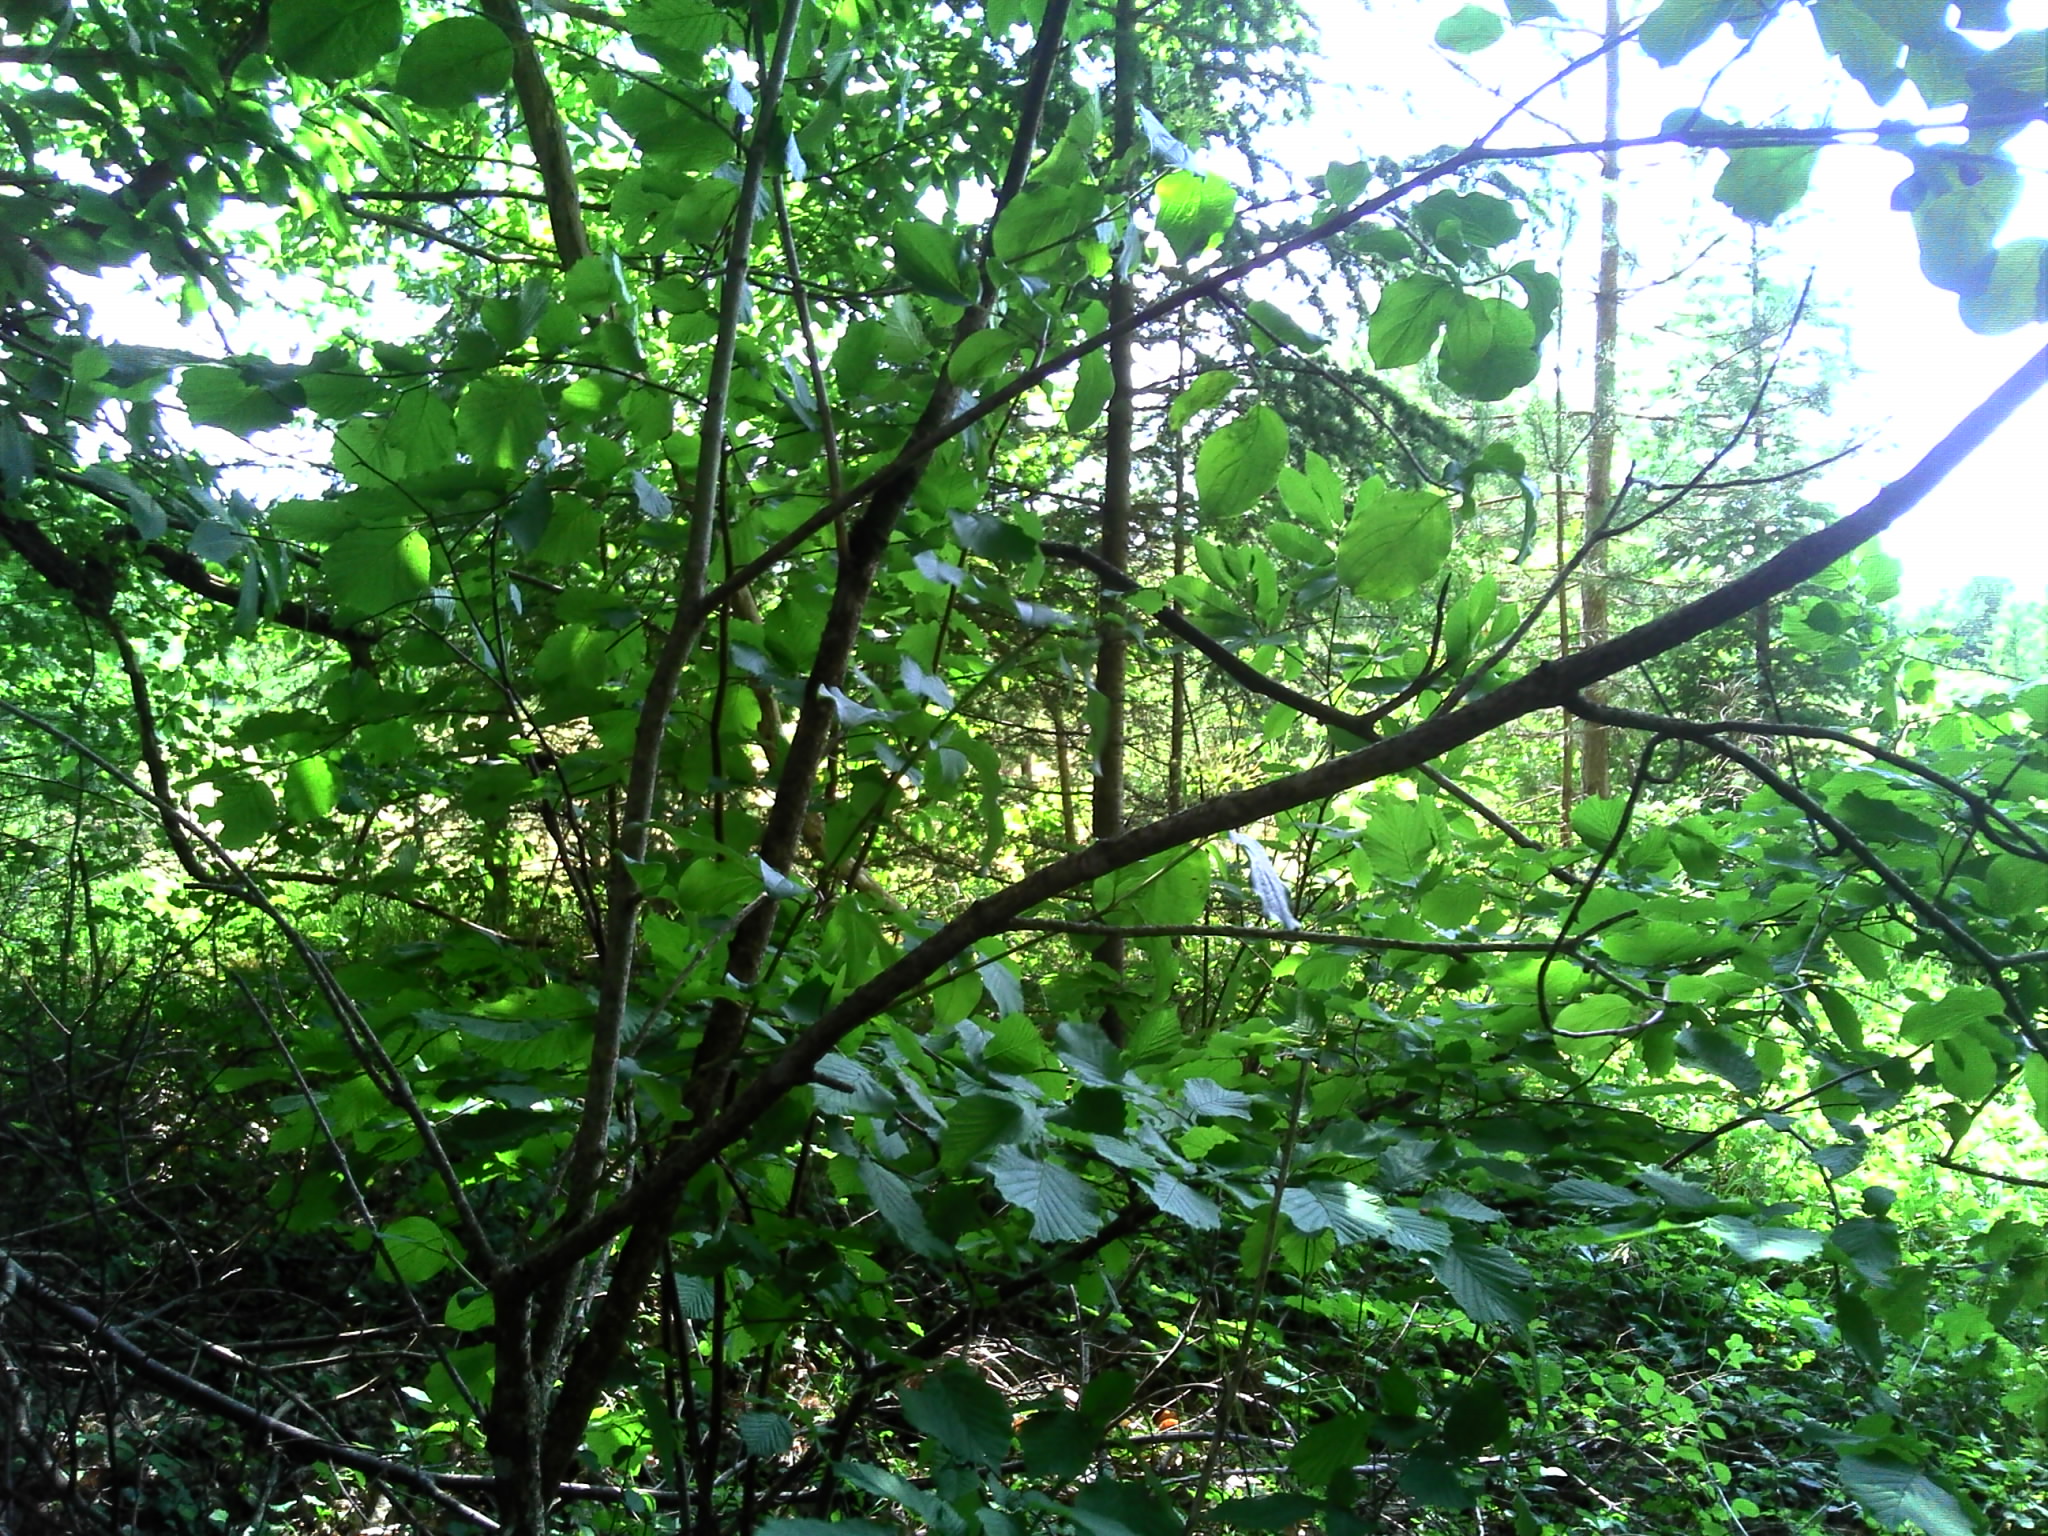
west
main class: Woodland
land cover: Broadleaved woodland
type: acidophilous oak and oak-birch forest
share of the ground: > 75 %
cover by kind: broadleaved forest trees 80 %, herbaceous plants 10 %, coniferous forest trees 5 %, shrubs 5 %
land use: Semi-natural and natural areas not in use
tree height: > 5 m
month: June
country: FR
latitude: 44.4500
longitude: 1.6679
